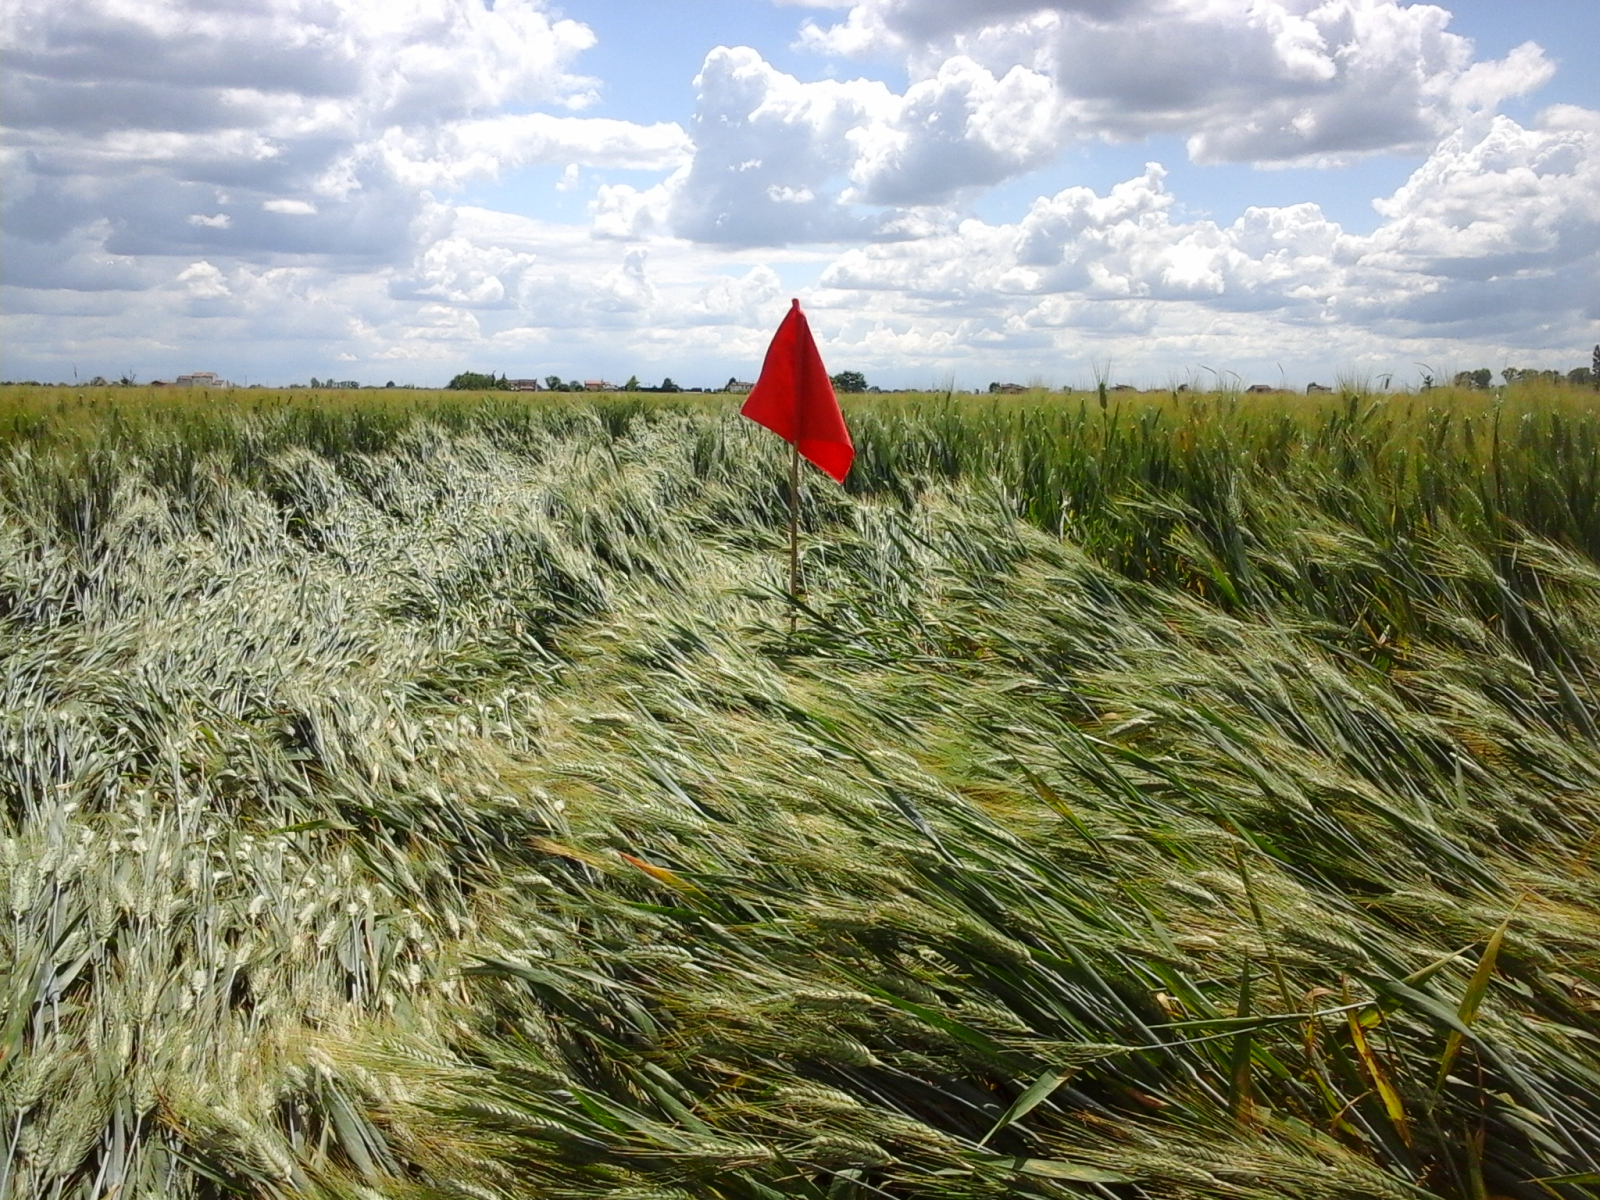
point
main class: Cropland
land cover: Durum wheat
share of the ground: > 75 %
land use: Agriculture (excluding fallow land and kitchen gardens)
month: May
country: IT
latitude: 45.0414
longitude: 11.6093
